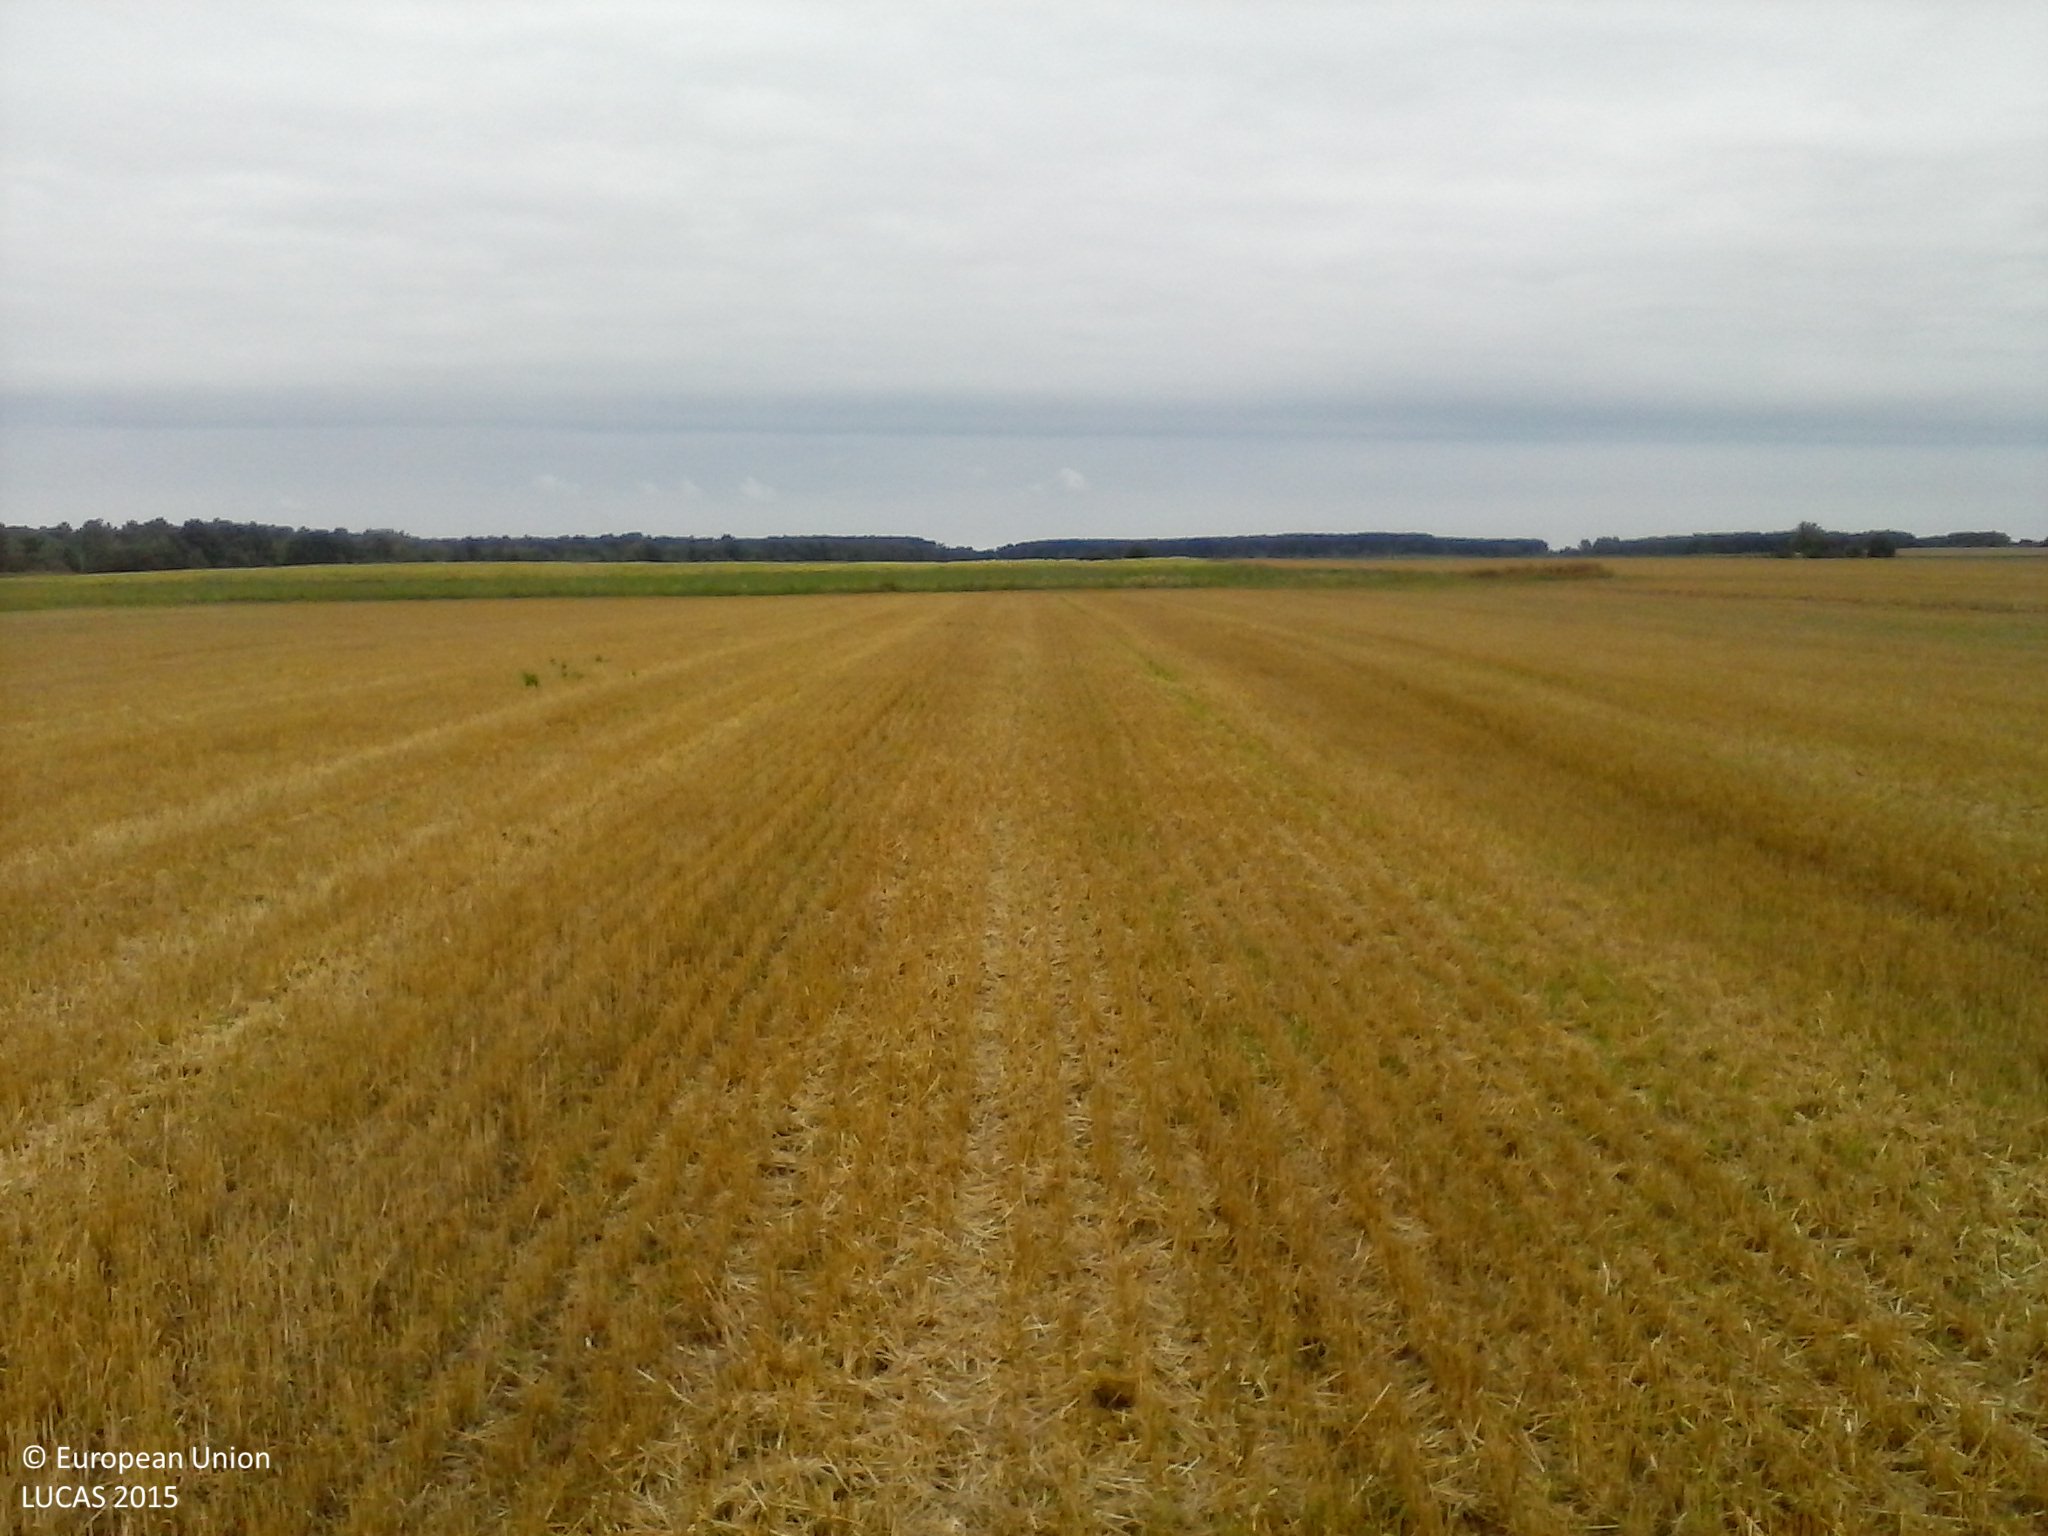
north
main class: Cropland
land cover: Common wheat
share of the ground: > 75 %
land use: Agriculture (excluding fallow land and kitchen gardens)
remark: Harvested field
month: July
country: HU
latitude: 46.0773
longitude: 17.6461
